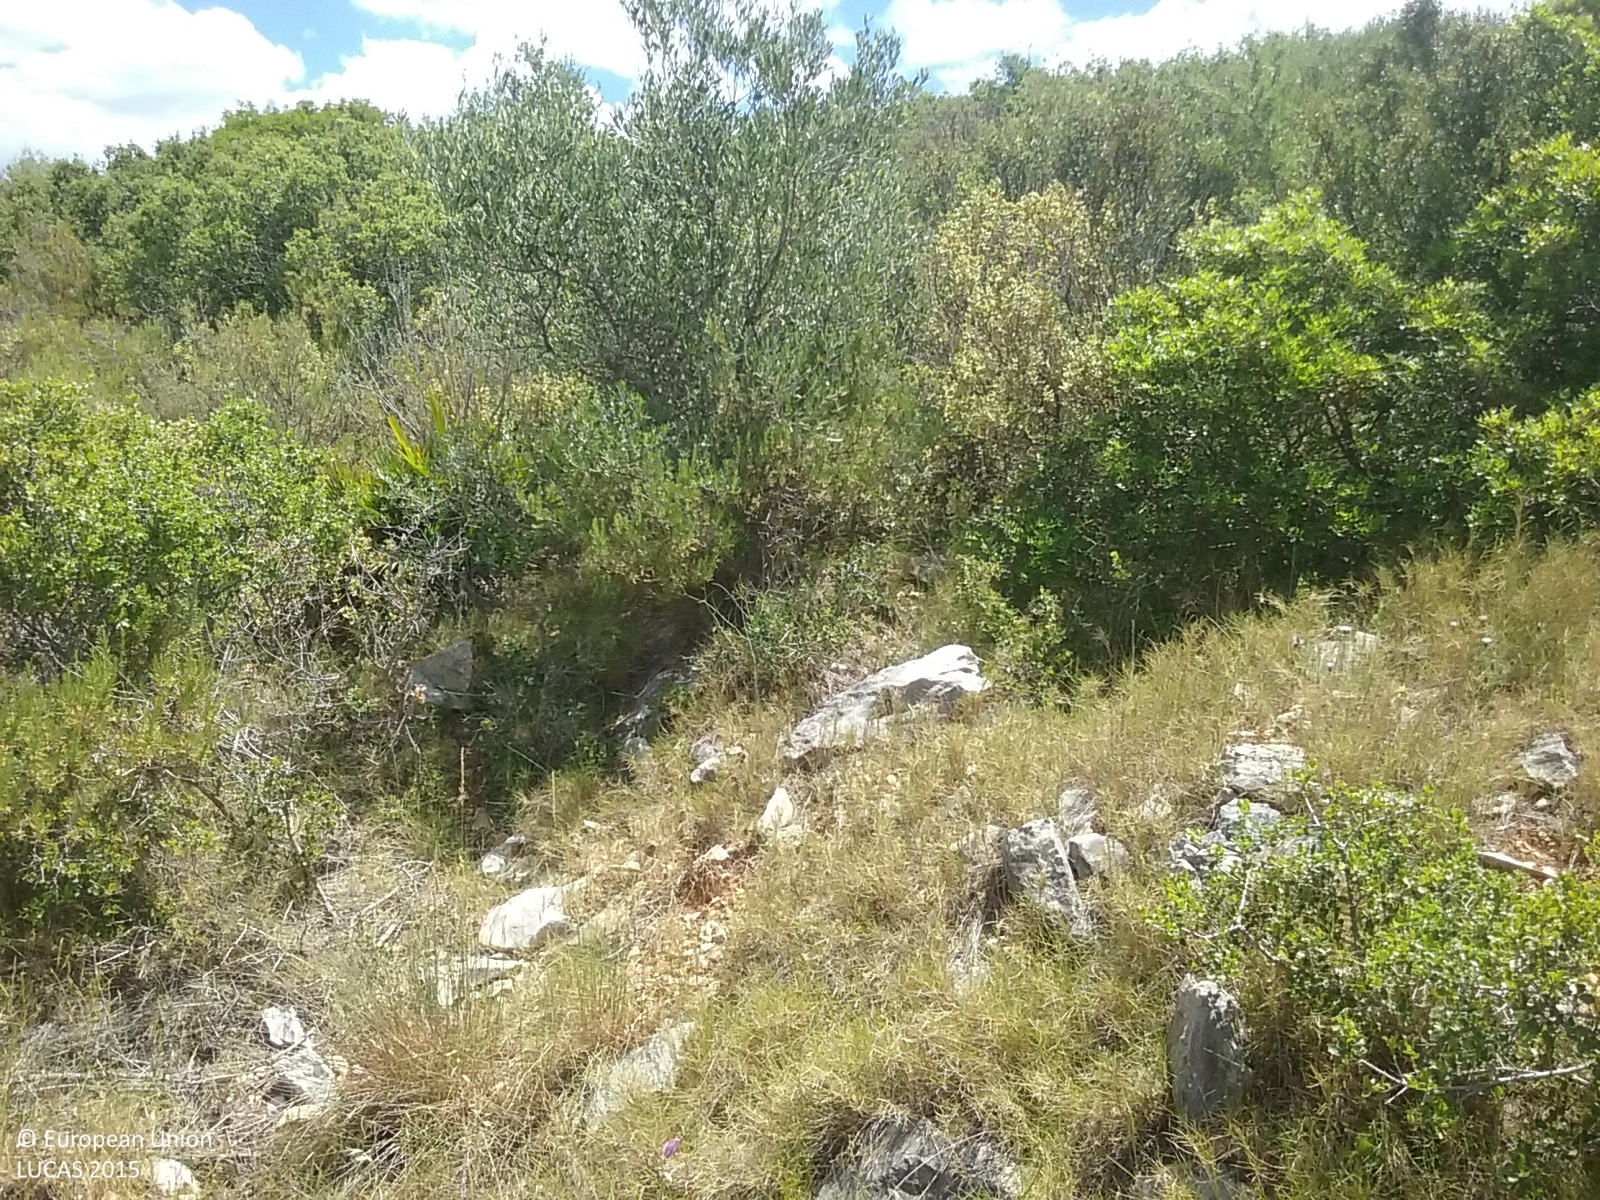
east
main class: Shrubland
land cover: Shrubland without tree cover
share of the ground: > 75 %
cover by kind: shrubs 95 %, herbaceous plants 5 %
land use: Semi-natural and natural areas not in use
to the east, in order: Shrubland without tree cover; Tracks; Shrubland without tree cover
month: May
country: ES
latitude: 40.3836
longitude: 0.0893
